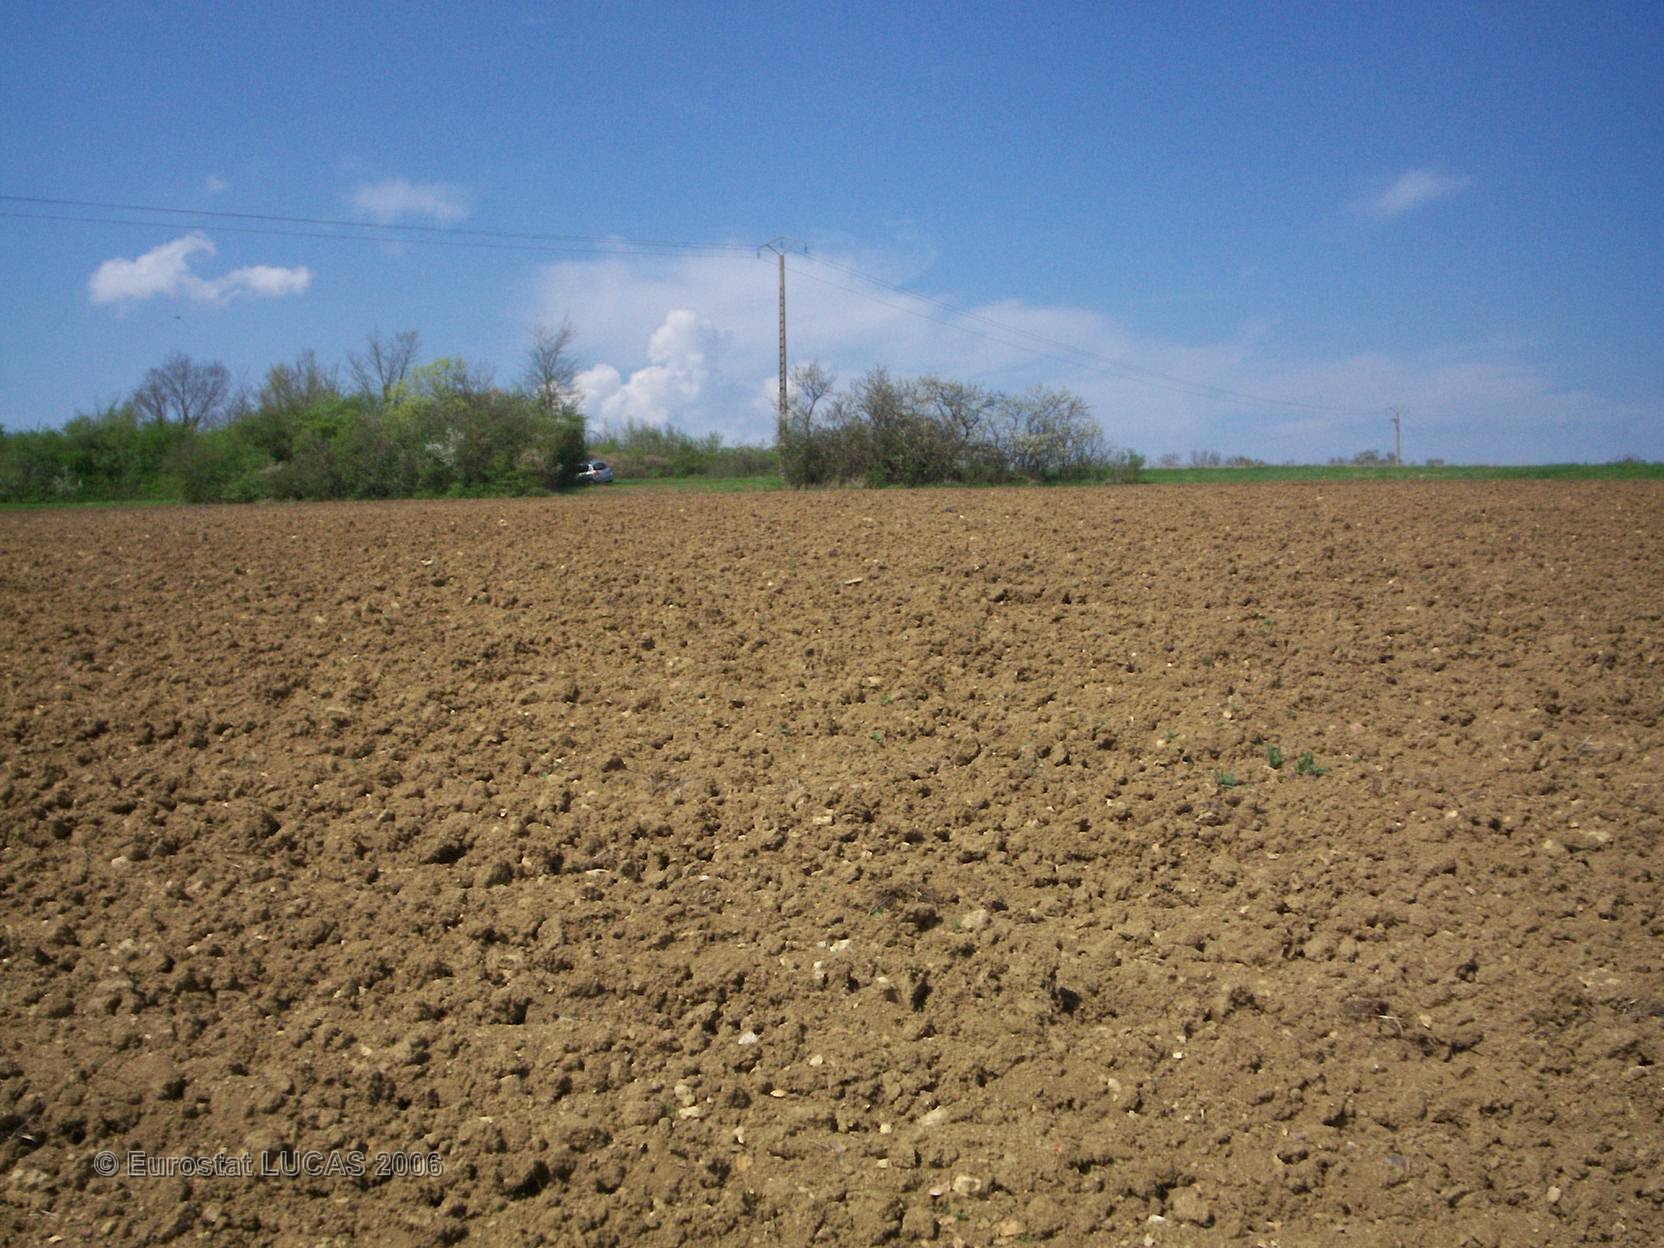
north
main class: Cropland
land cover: Sunflower
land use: Agriculture (excluding fallow land and kitchen gardens)
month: May
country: FR
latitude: 47.3663
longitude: 2.9631
